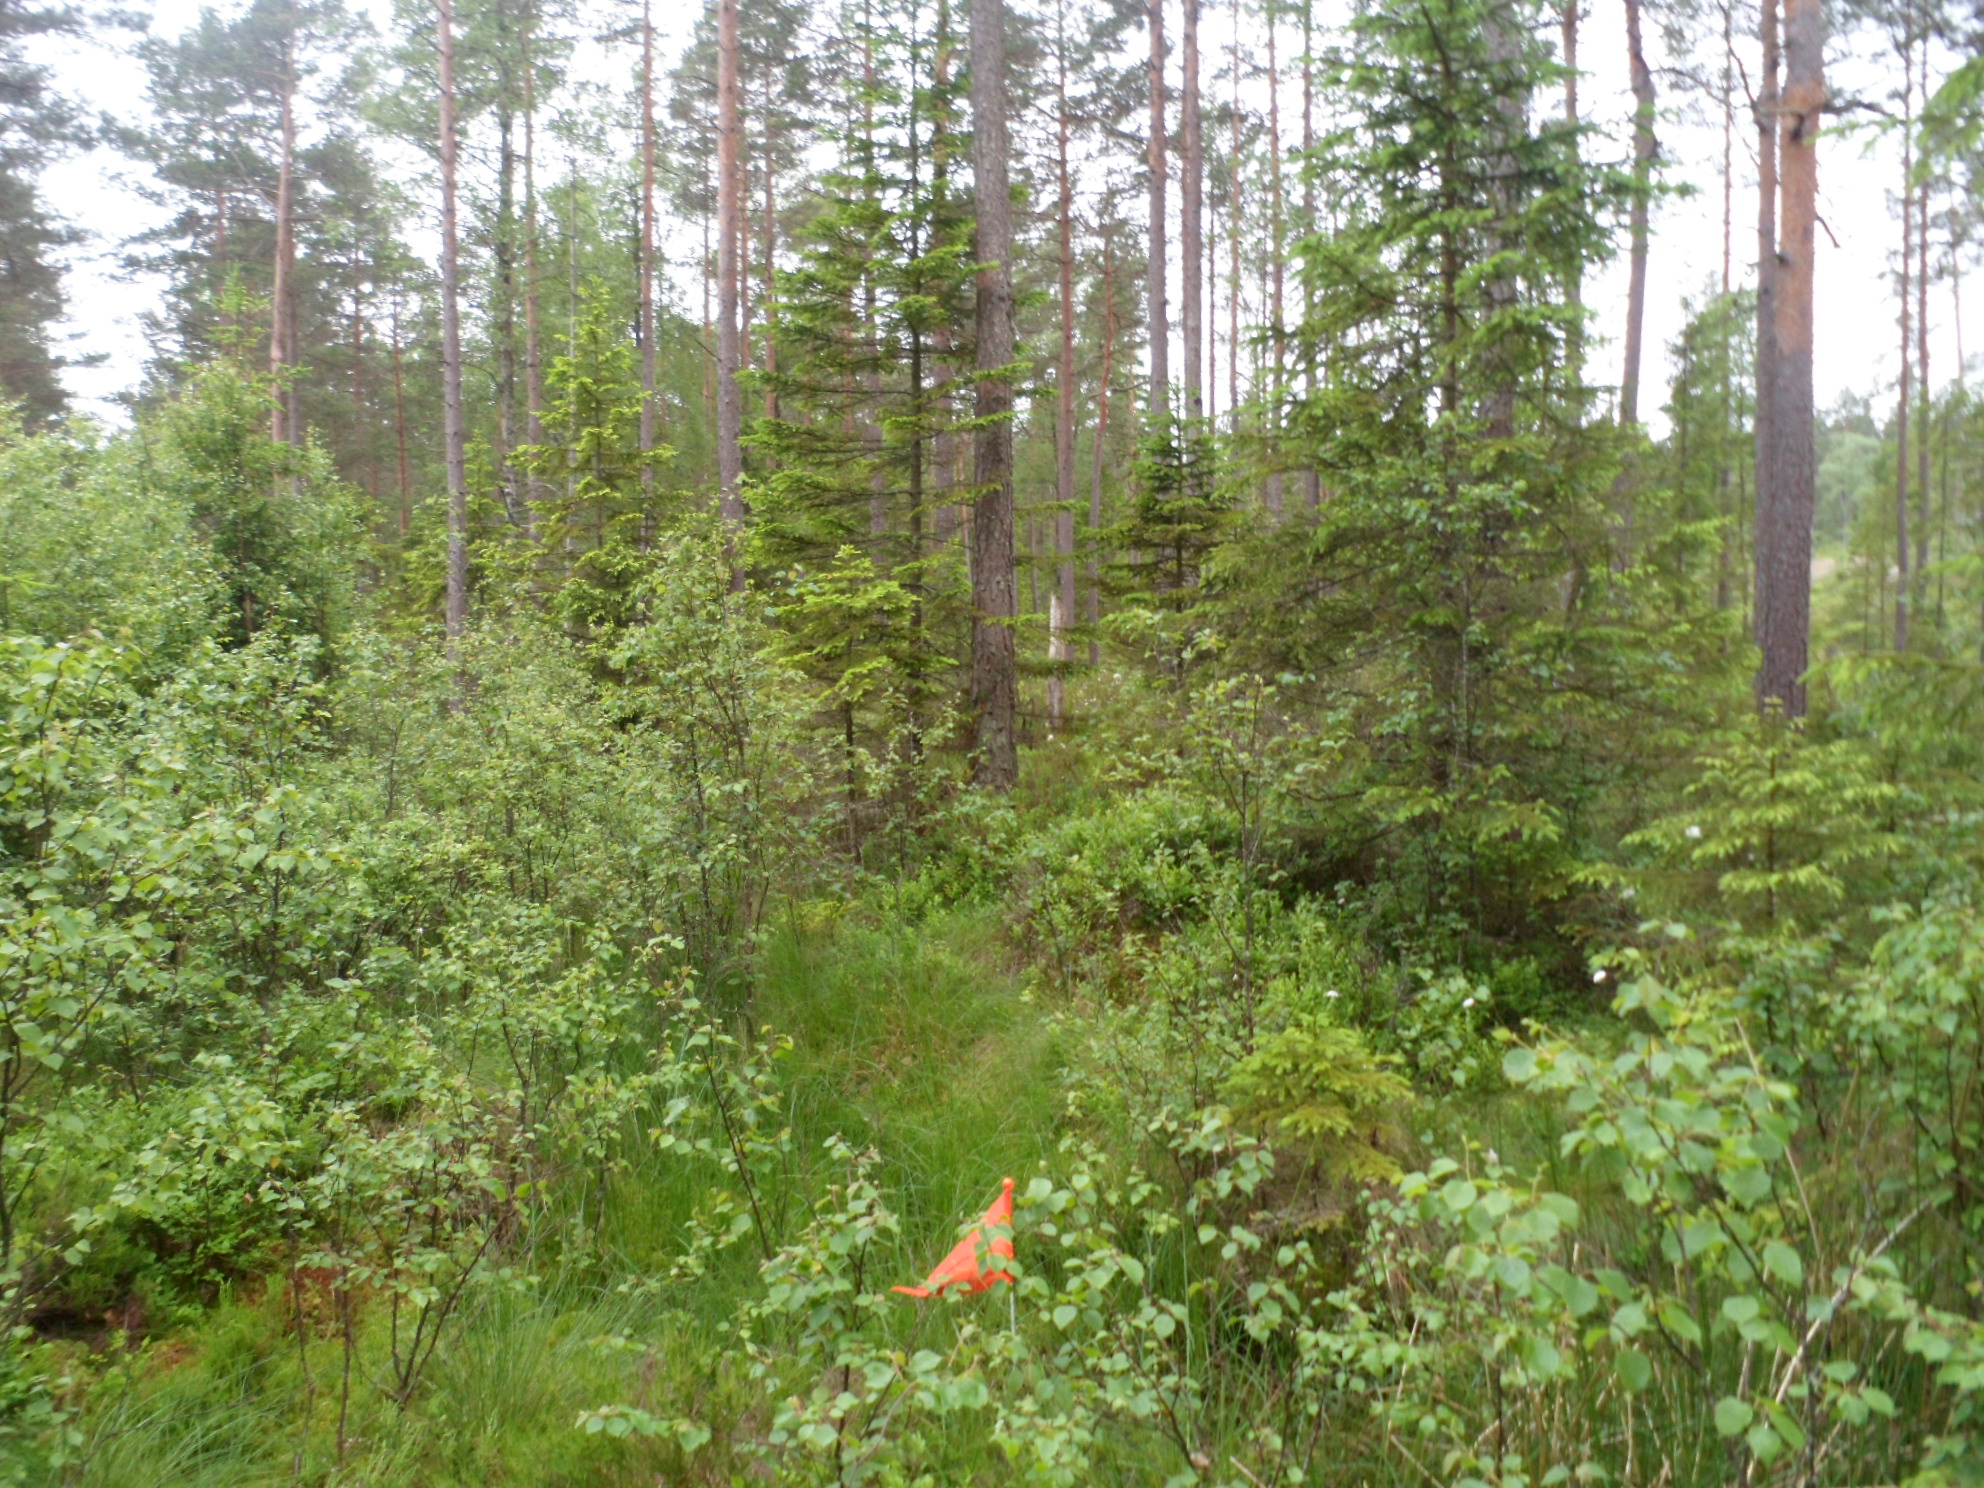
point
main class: Woodland
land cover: Spruce dominated mixed woodland
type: boreal forest
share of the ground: 50 - 75 %
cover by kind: coniferous forest trees 30 %, broadleaved forest trees 30 %, shrubs 20 %, herbaceous plants 10 %, lichens and mosses 10 %
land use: Forestry
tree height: > 5 m
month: June
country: SE
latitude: 57.0506
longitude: 15.3222
